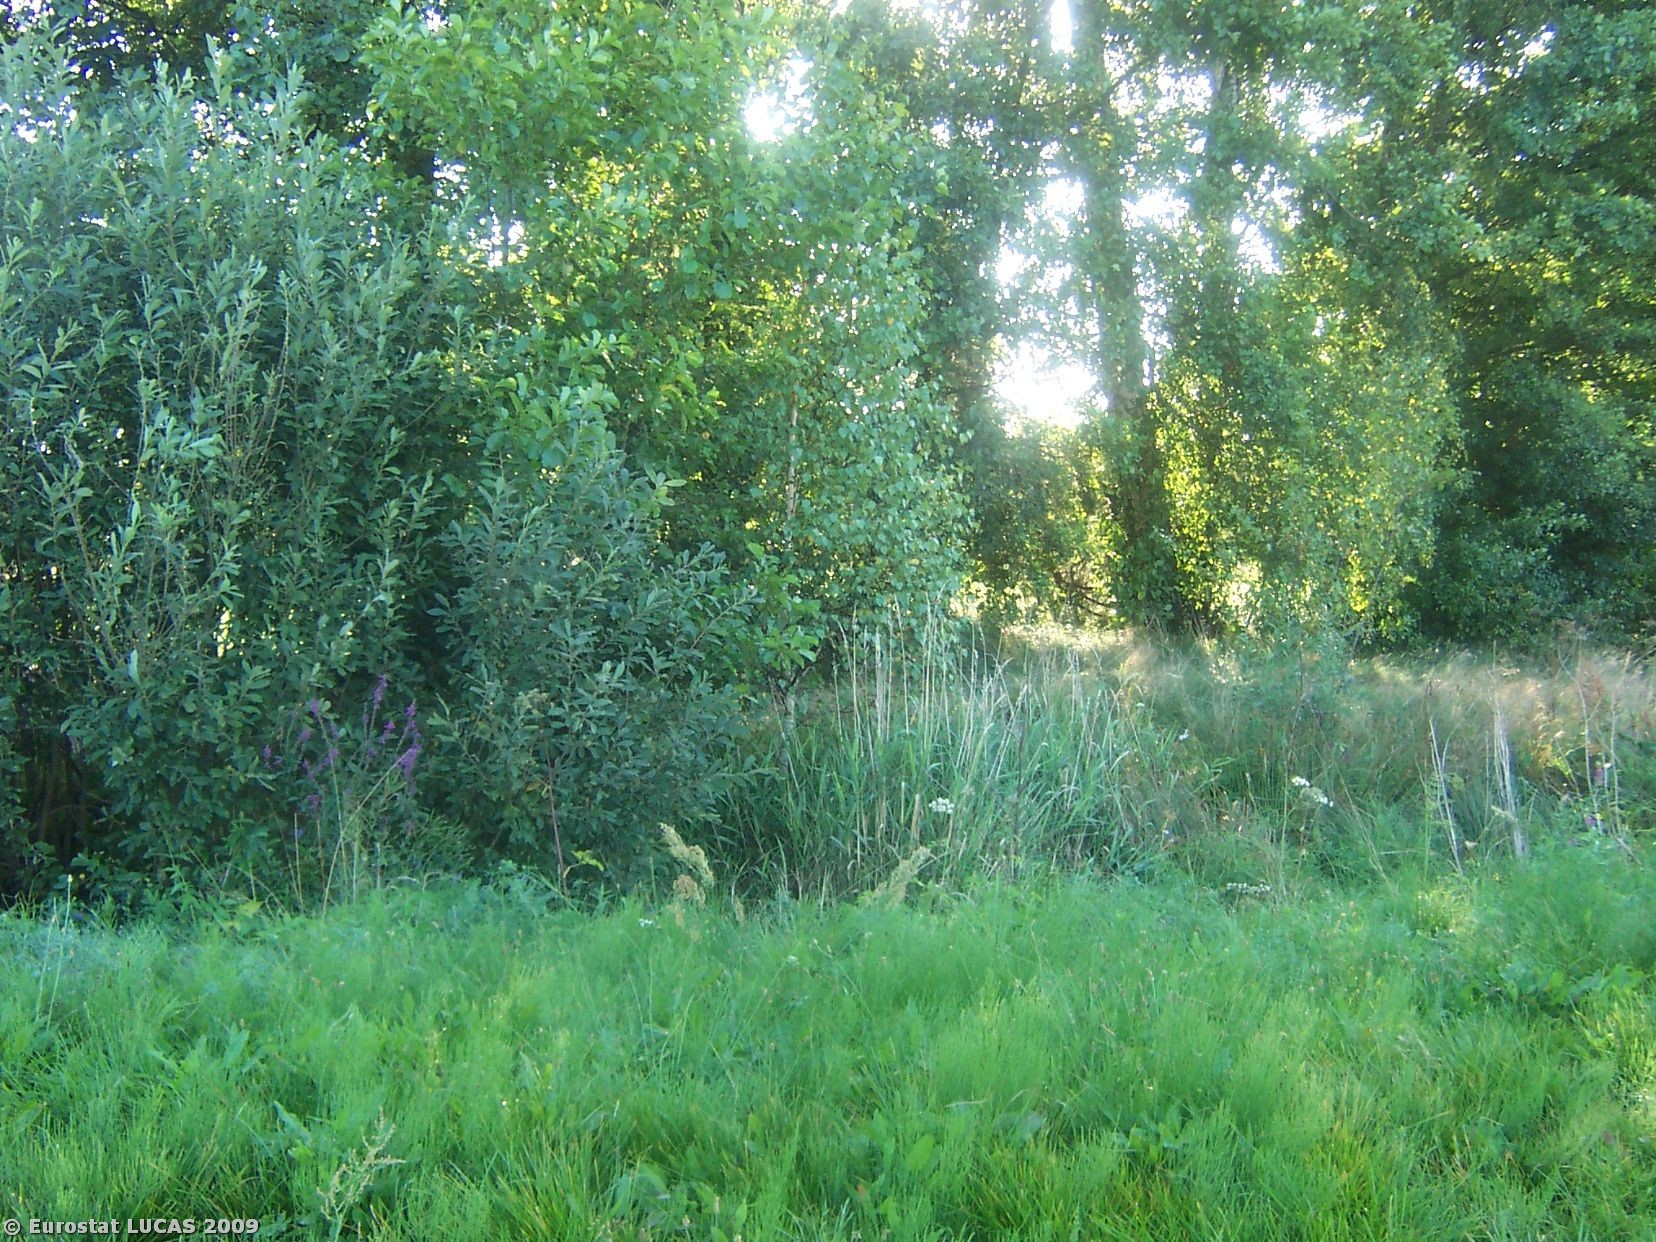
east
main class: Grassland
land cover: Grassland without tree/shrub cover
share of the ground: > 75 %
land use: Agriculture (excluding fallow land and kitchen gardens)
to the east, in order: Grassland without tree/shrub cover; Ditches and canals; Tracks; Lines of trees; Grassland with sparse tree/shrub cover; Tracks; Rye; Mixed woodland; Common wheat; Grassland without tree/shrub cover
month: August
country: PL
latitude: 52.6522
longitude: 21.1173
